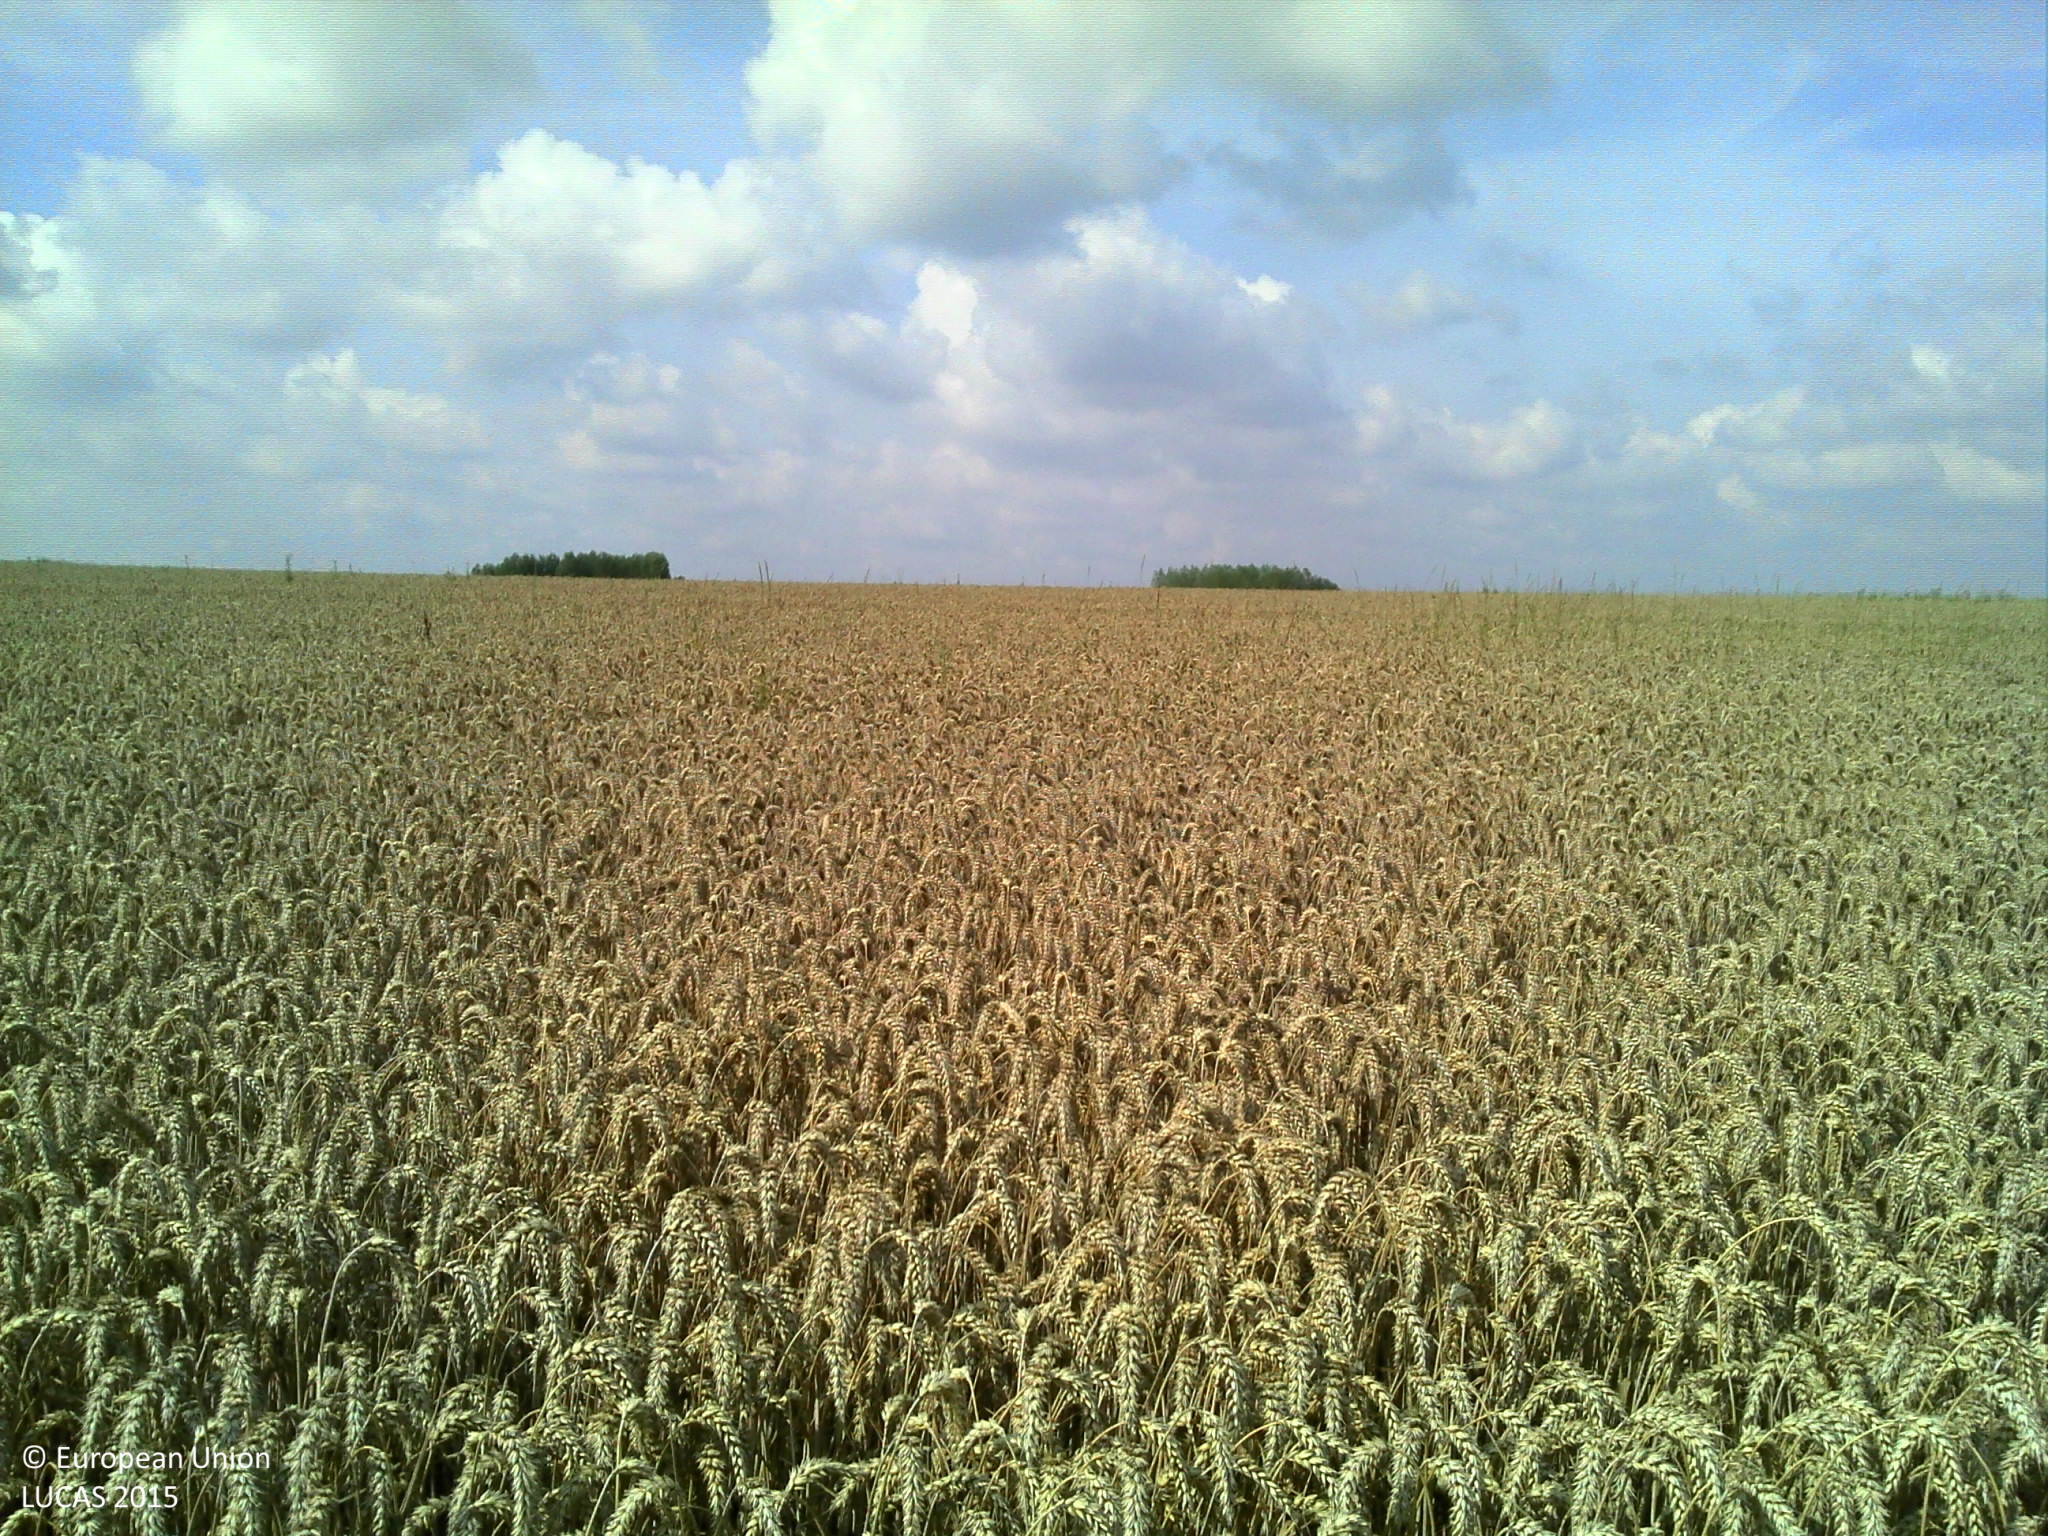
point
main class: Cropland
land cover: Common wheat
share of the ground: > 75 %
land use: Agriculture (excluding fallow land and kitchen gardens)
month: July
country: FR
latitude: 50.1001
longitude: 2.5081
